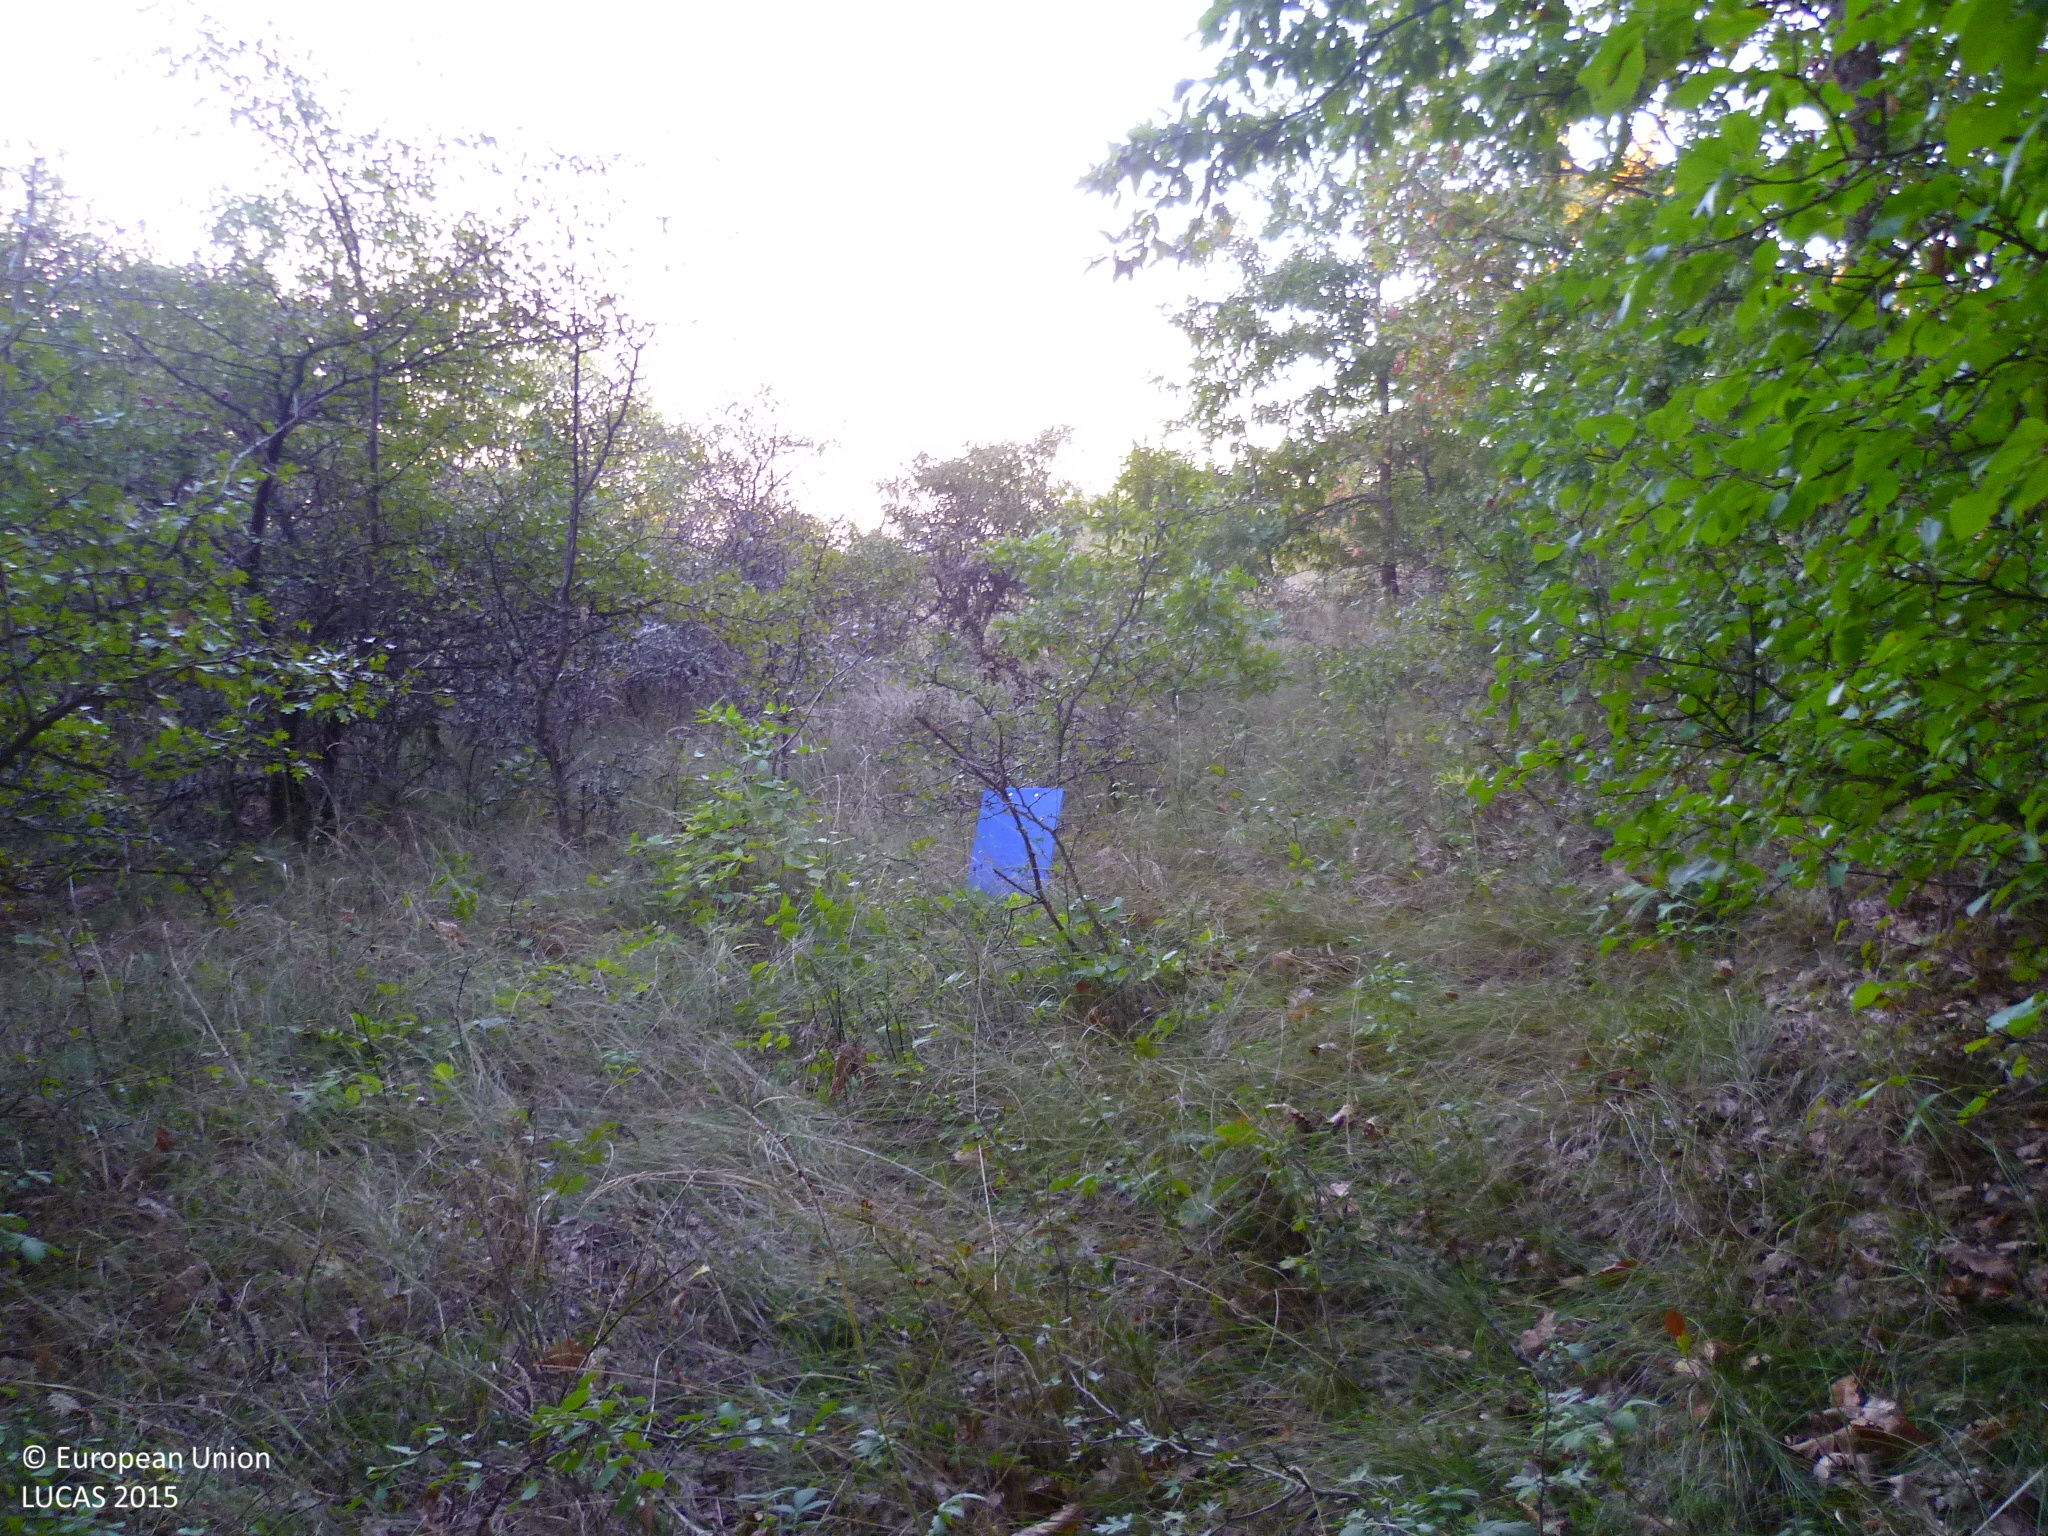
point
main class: Woodland
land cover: Broadleaved woodland
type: mesophytic deciduous forest
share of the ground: > 75 %
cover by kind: broadleaved forest trees 55 %, shrubs 30 %, herbaceous plants 15 %
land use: Semi-natural and natural areas not in use
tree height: > 5 m
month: October
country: BG
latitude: 43.0121
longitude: 22.9017
